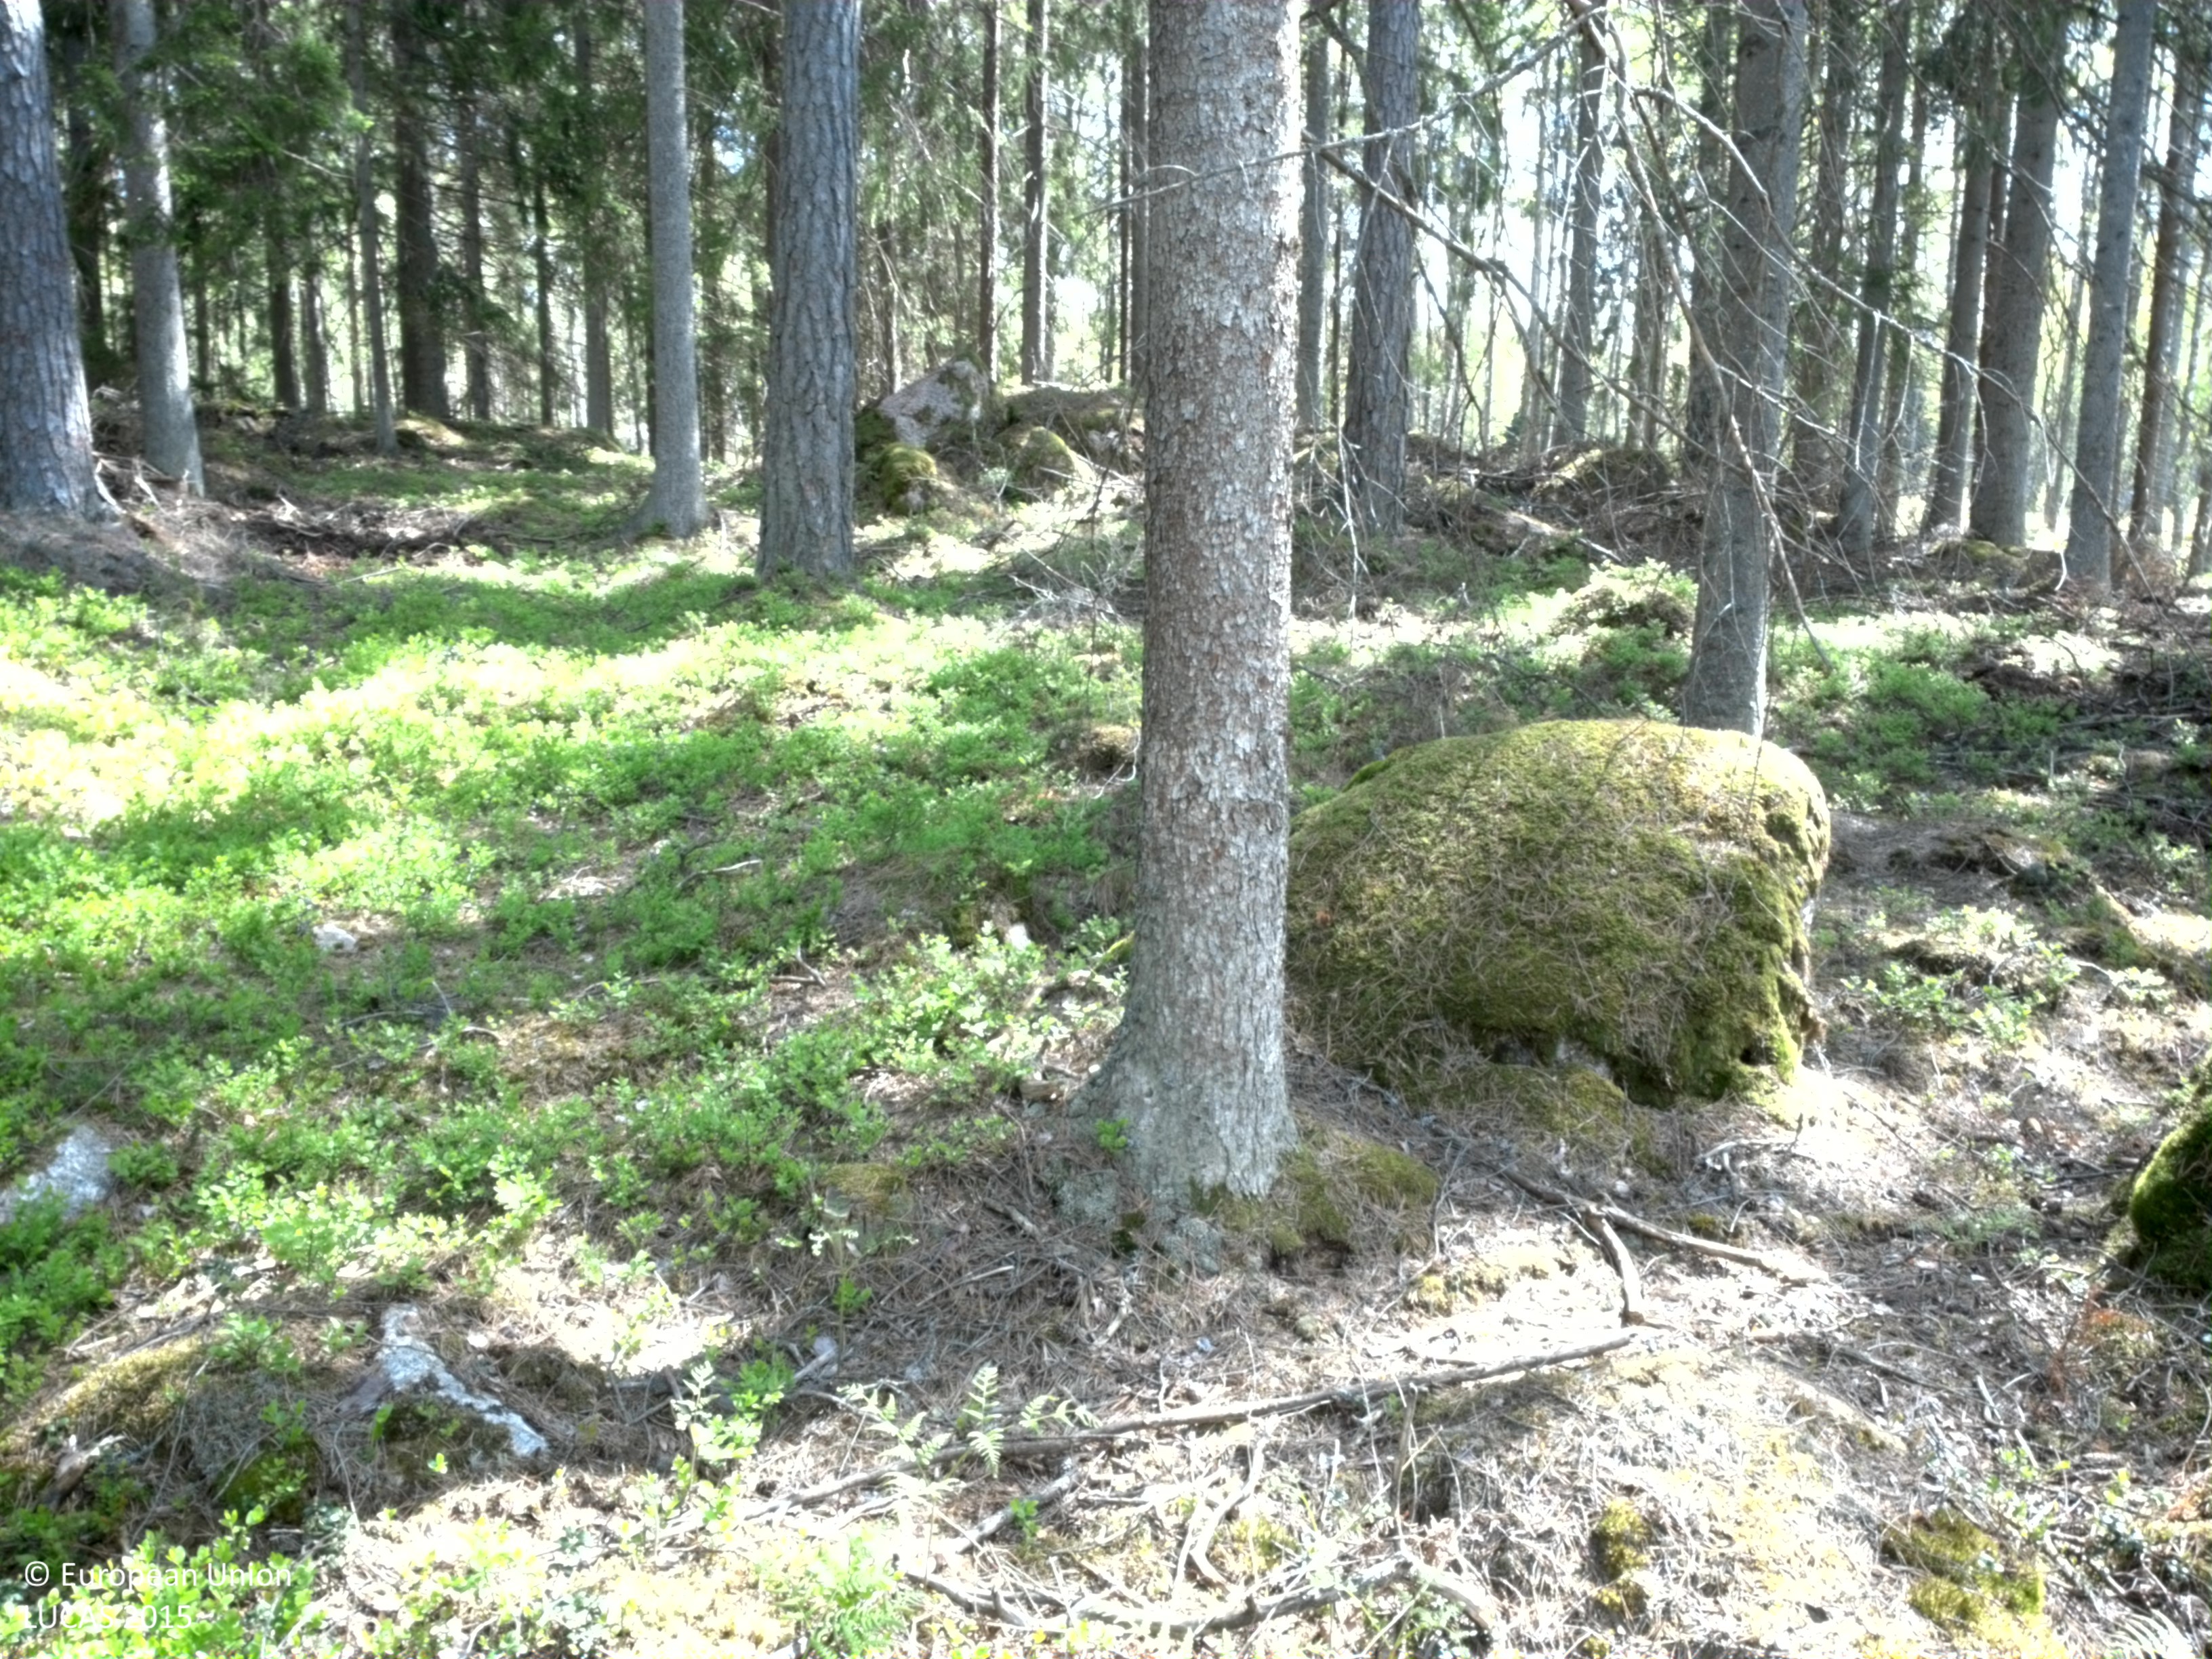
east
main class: Woodland
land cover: Spruce dominated coniferous woodland
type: boreal forest
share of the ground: > 75 %
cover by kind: coniferous forest trees 80 %, shrubs 10 %, herbaceous plants 5 %, lichens and mosses 5 %
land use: Forestry
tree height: > 5 m
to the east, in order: Spruce dominated coniferous woodland; Broadleaved woodland; Shrubland without tree cover; Electric lines; Shrubland without tree cover; Spruce dominated mixed woodland; Pine dominated coniferous woodland; Spruce dominated mixed woodland
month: May
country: SE
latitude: 56.5090
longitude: 15.3447
